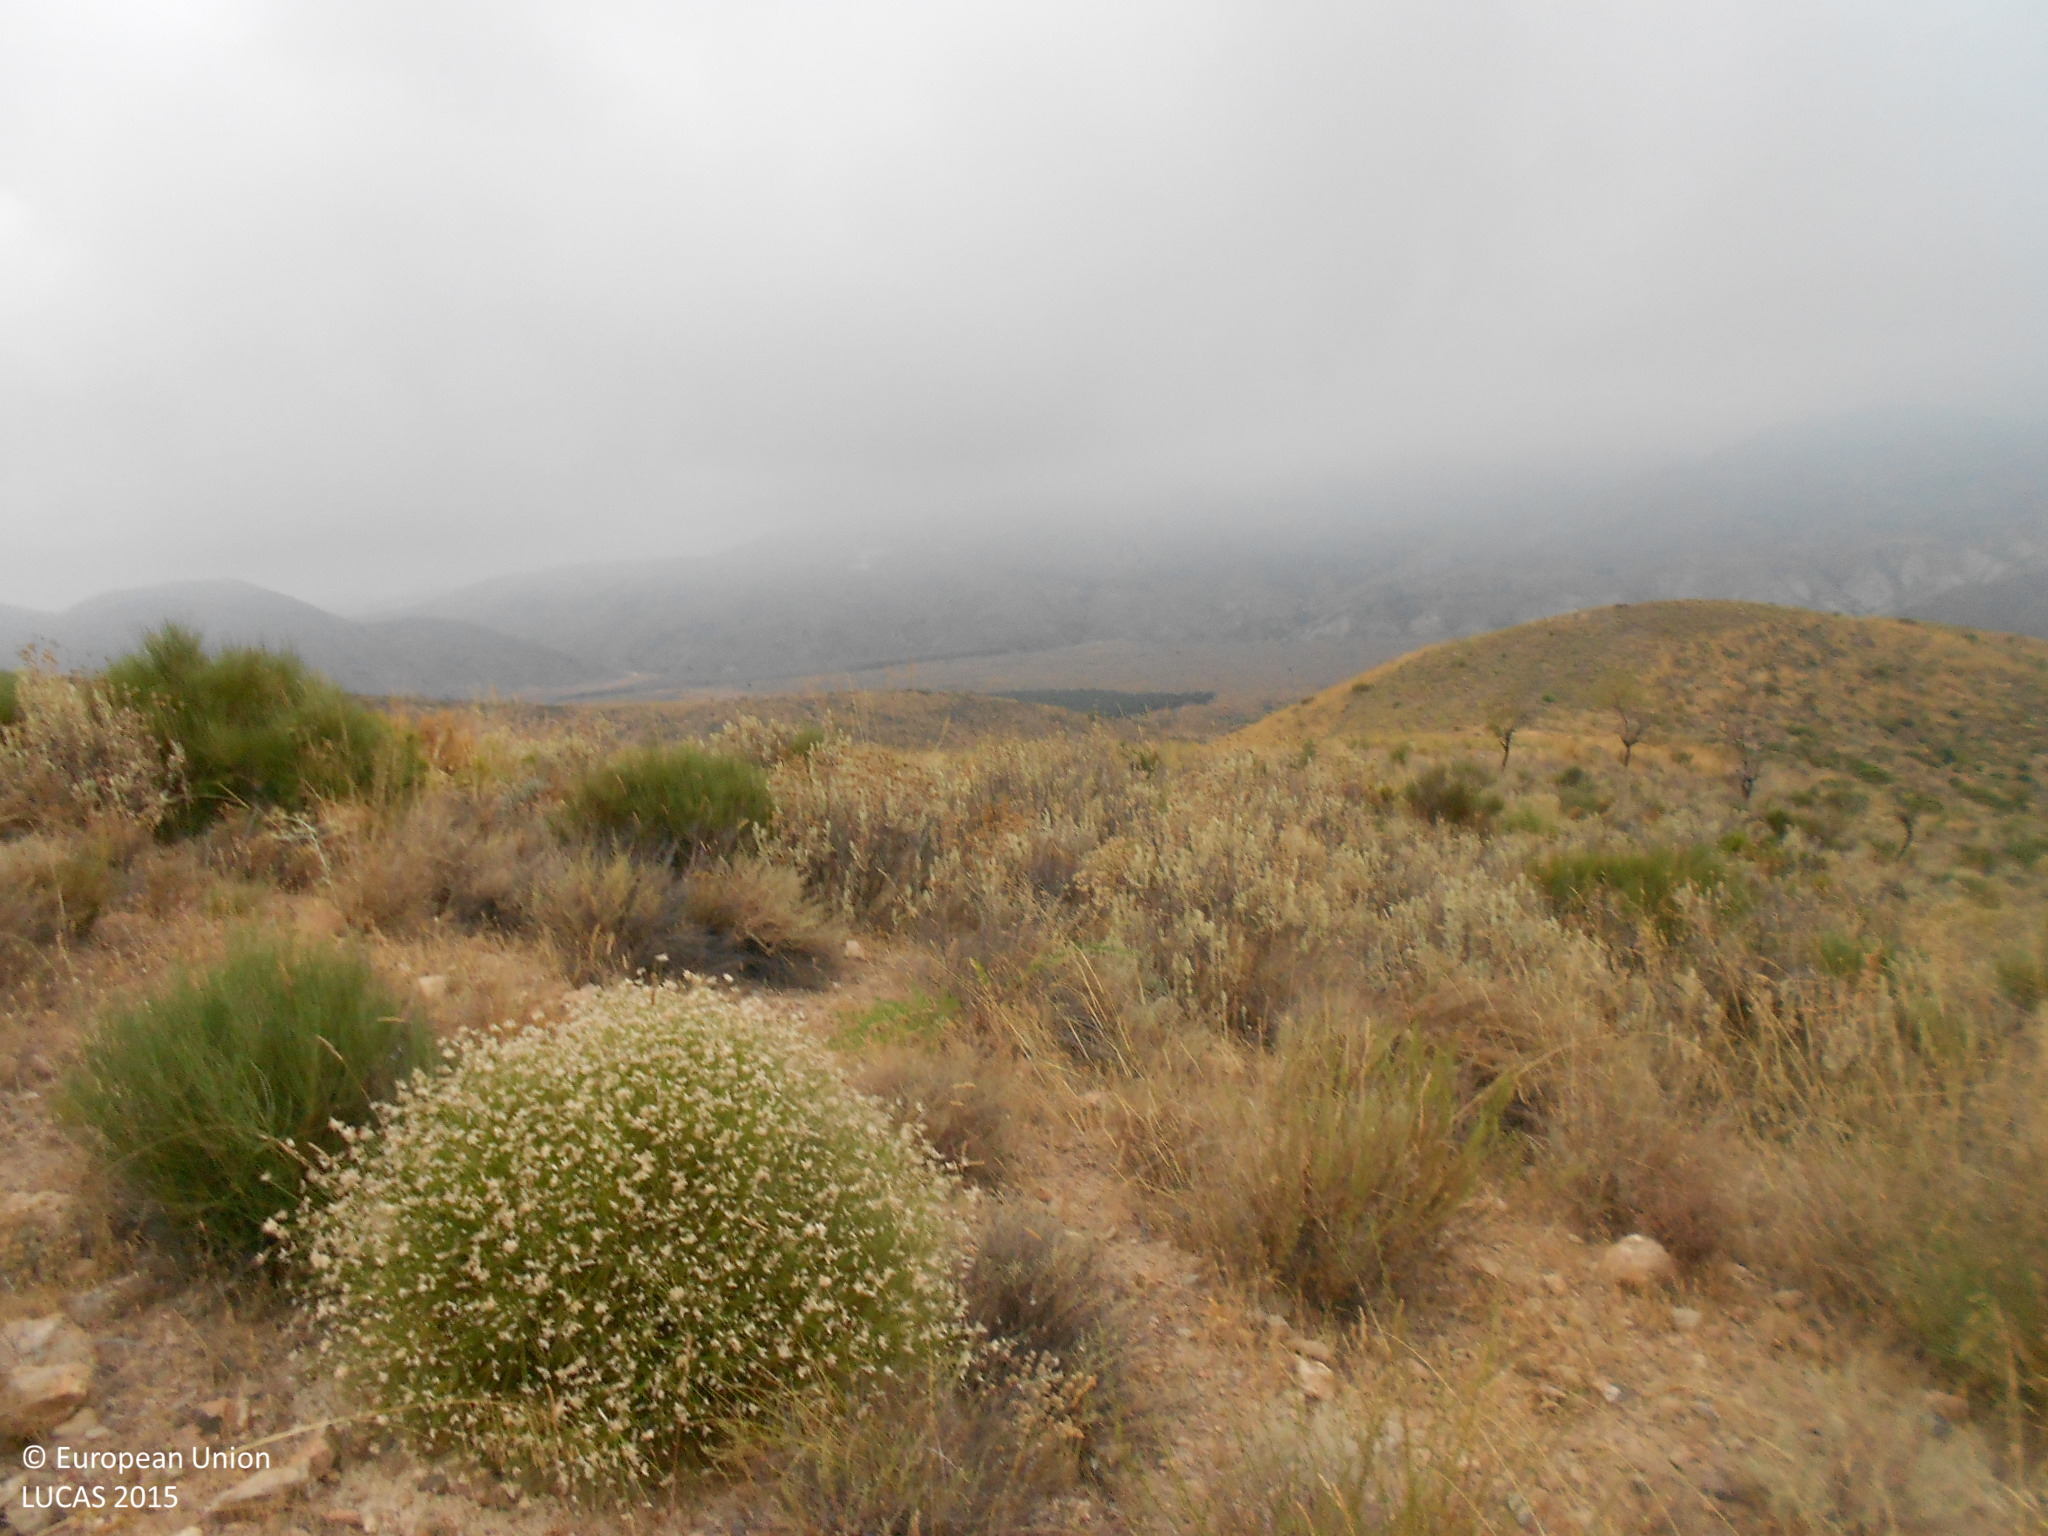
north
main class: Cropland
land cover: Nuts trees
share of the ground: 10 - 25 %
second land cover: Shrubland without tree cover
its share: 25 - 50 %
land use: Abandoned areas
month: July
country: ES
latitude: 36.9709
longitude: -2.7959
